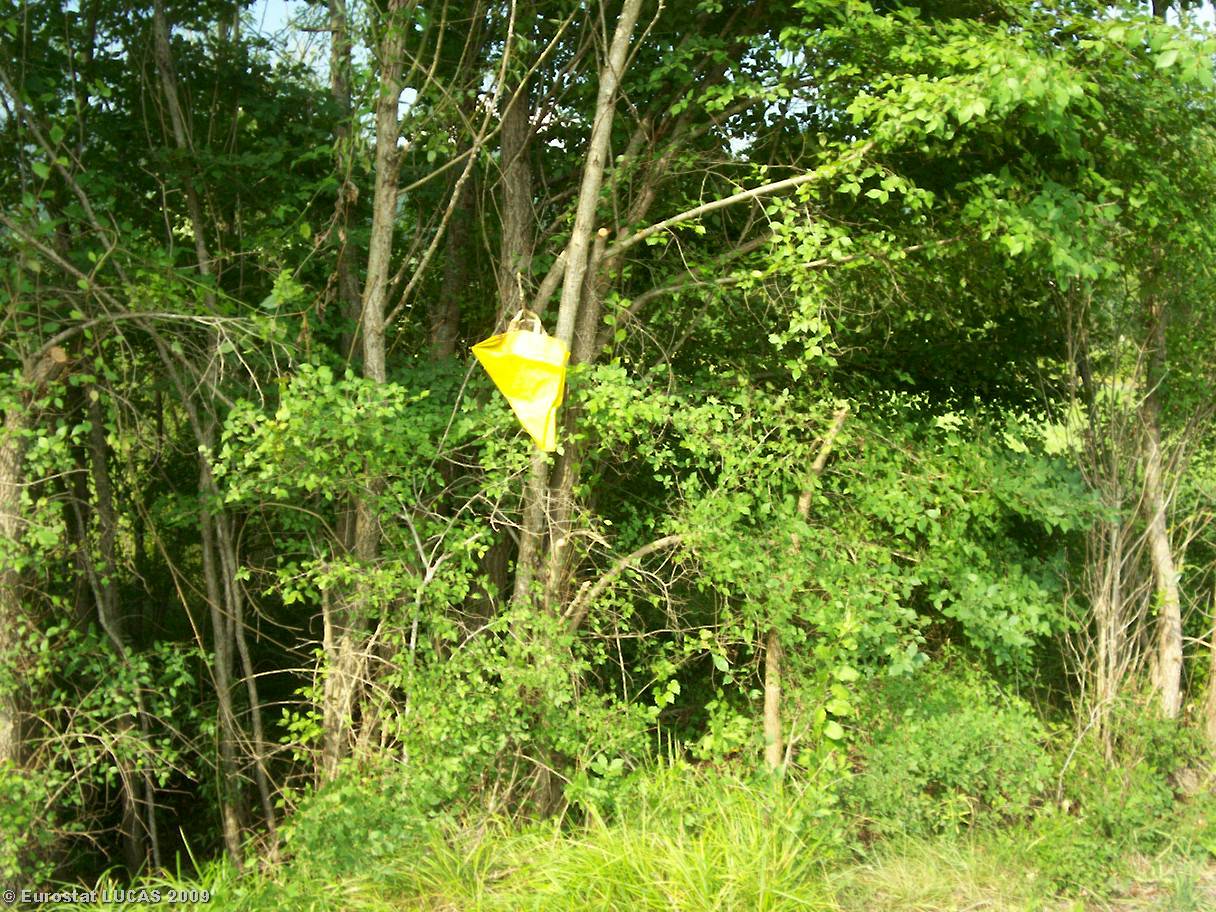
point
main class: Shrubland
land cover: Shrubland with sparse tree cover
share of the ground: > 75 %
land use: Unused
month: July
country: IT
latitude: 44.2604
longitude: 9.9875
